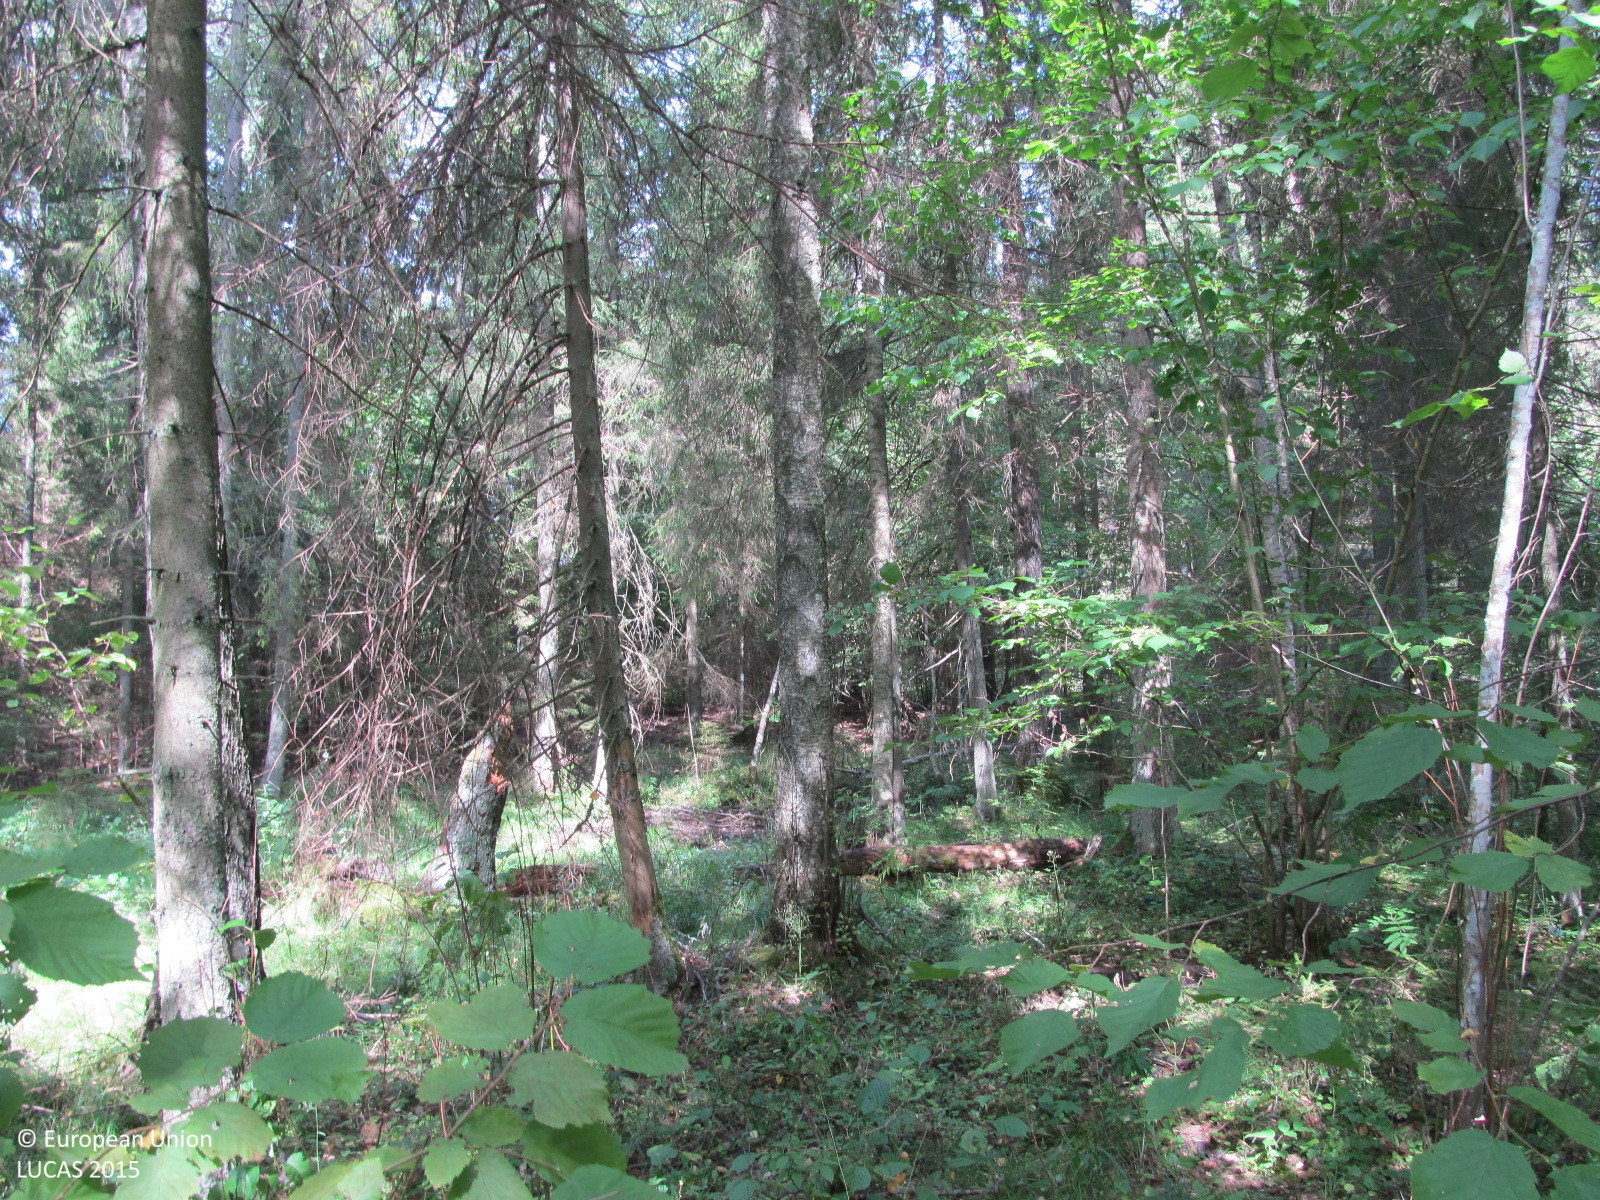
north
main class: Woodland
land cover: Spruce dominated mixed woodland
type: hemiboreal forest and nemoral coniferous forest and mixed broadleaved-coniferous forest
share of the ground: > 75 %
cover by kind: coniferous forest trees 45 %, broadleaved forest trees 40 %, herbaceous plants 10 %, shrubs 5 %
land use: Forestry
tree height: > 5 m
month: August
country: LT
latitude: 55.7782
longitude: 22.9988
